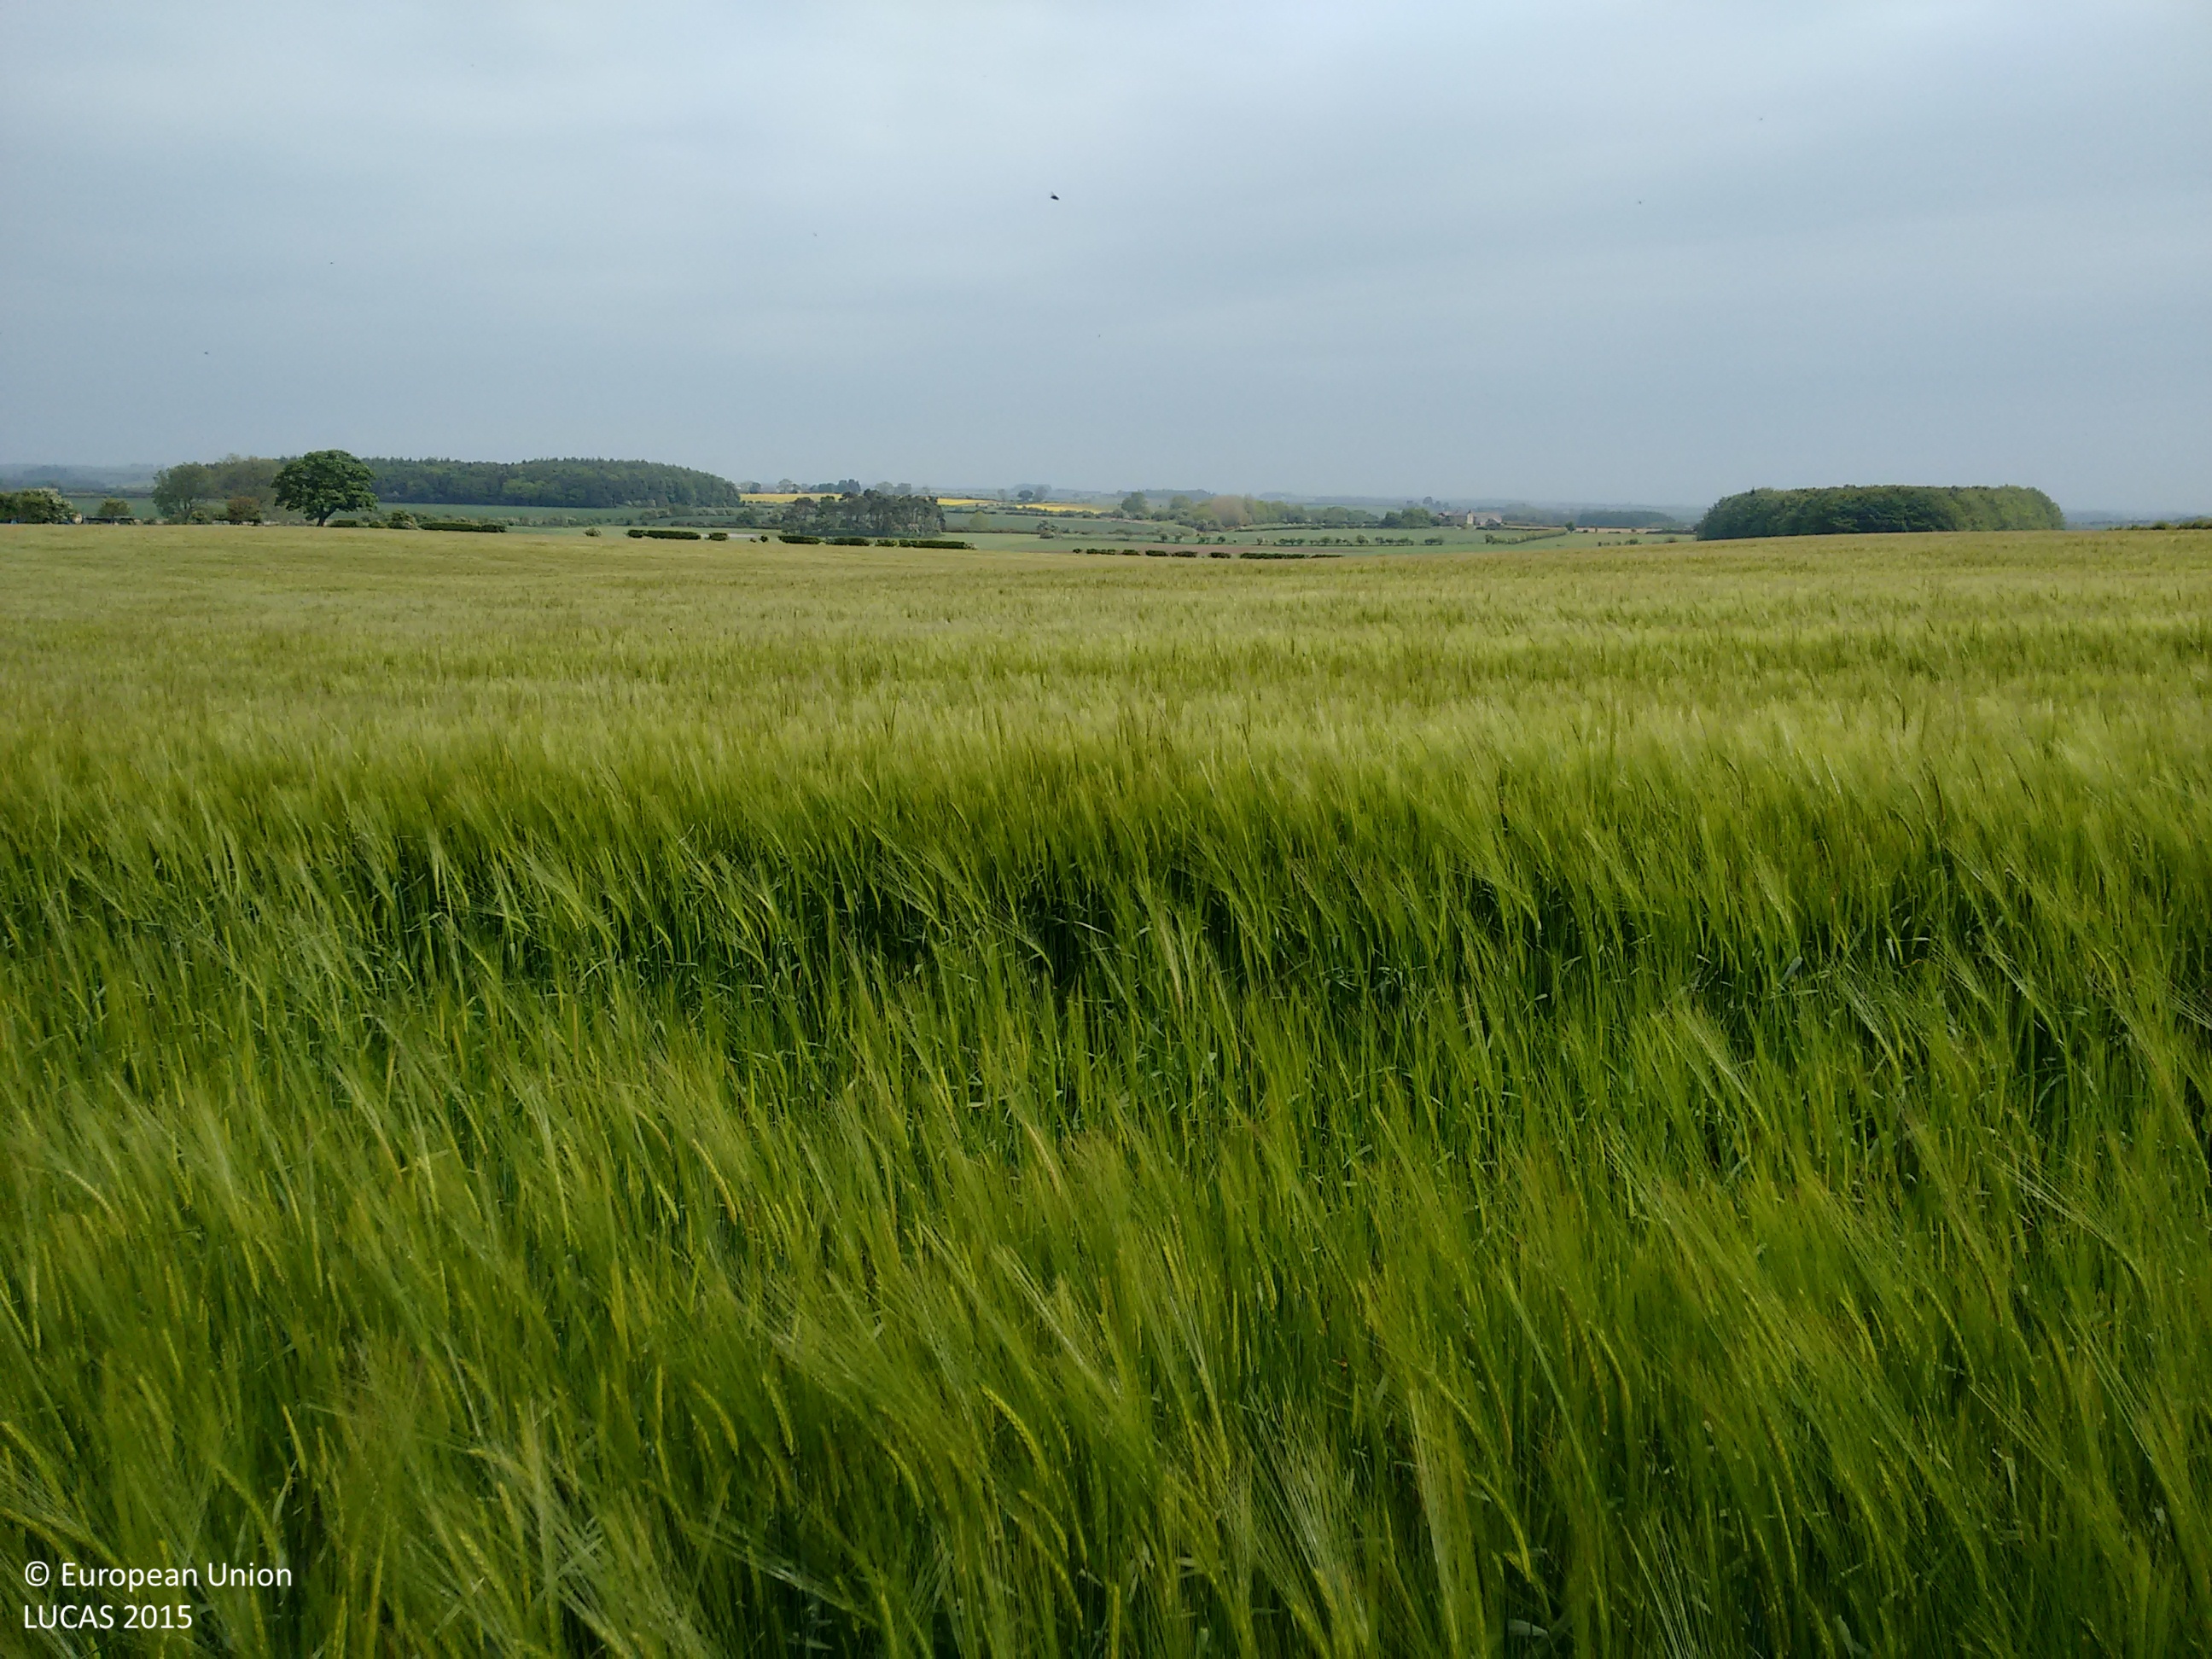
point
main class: Cropland
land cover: Barley
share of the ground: > 75 %
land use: Agriculture (excluding fallow land and kitchen gardens)
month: June
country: GB
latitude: 55.5358
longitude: -1.7589
